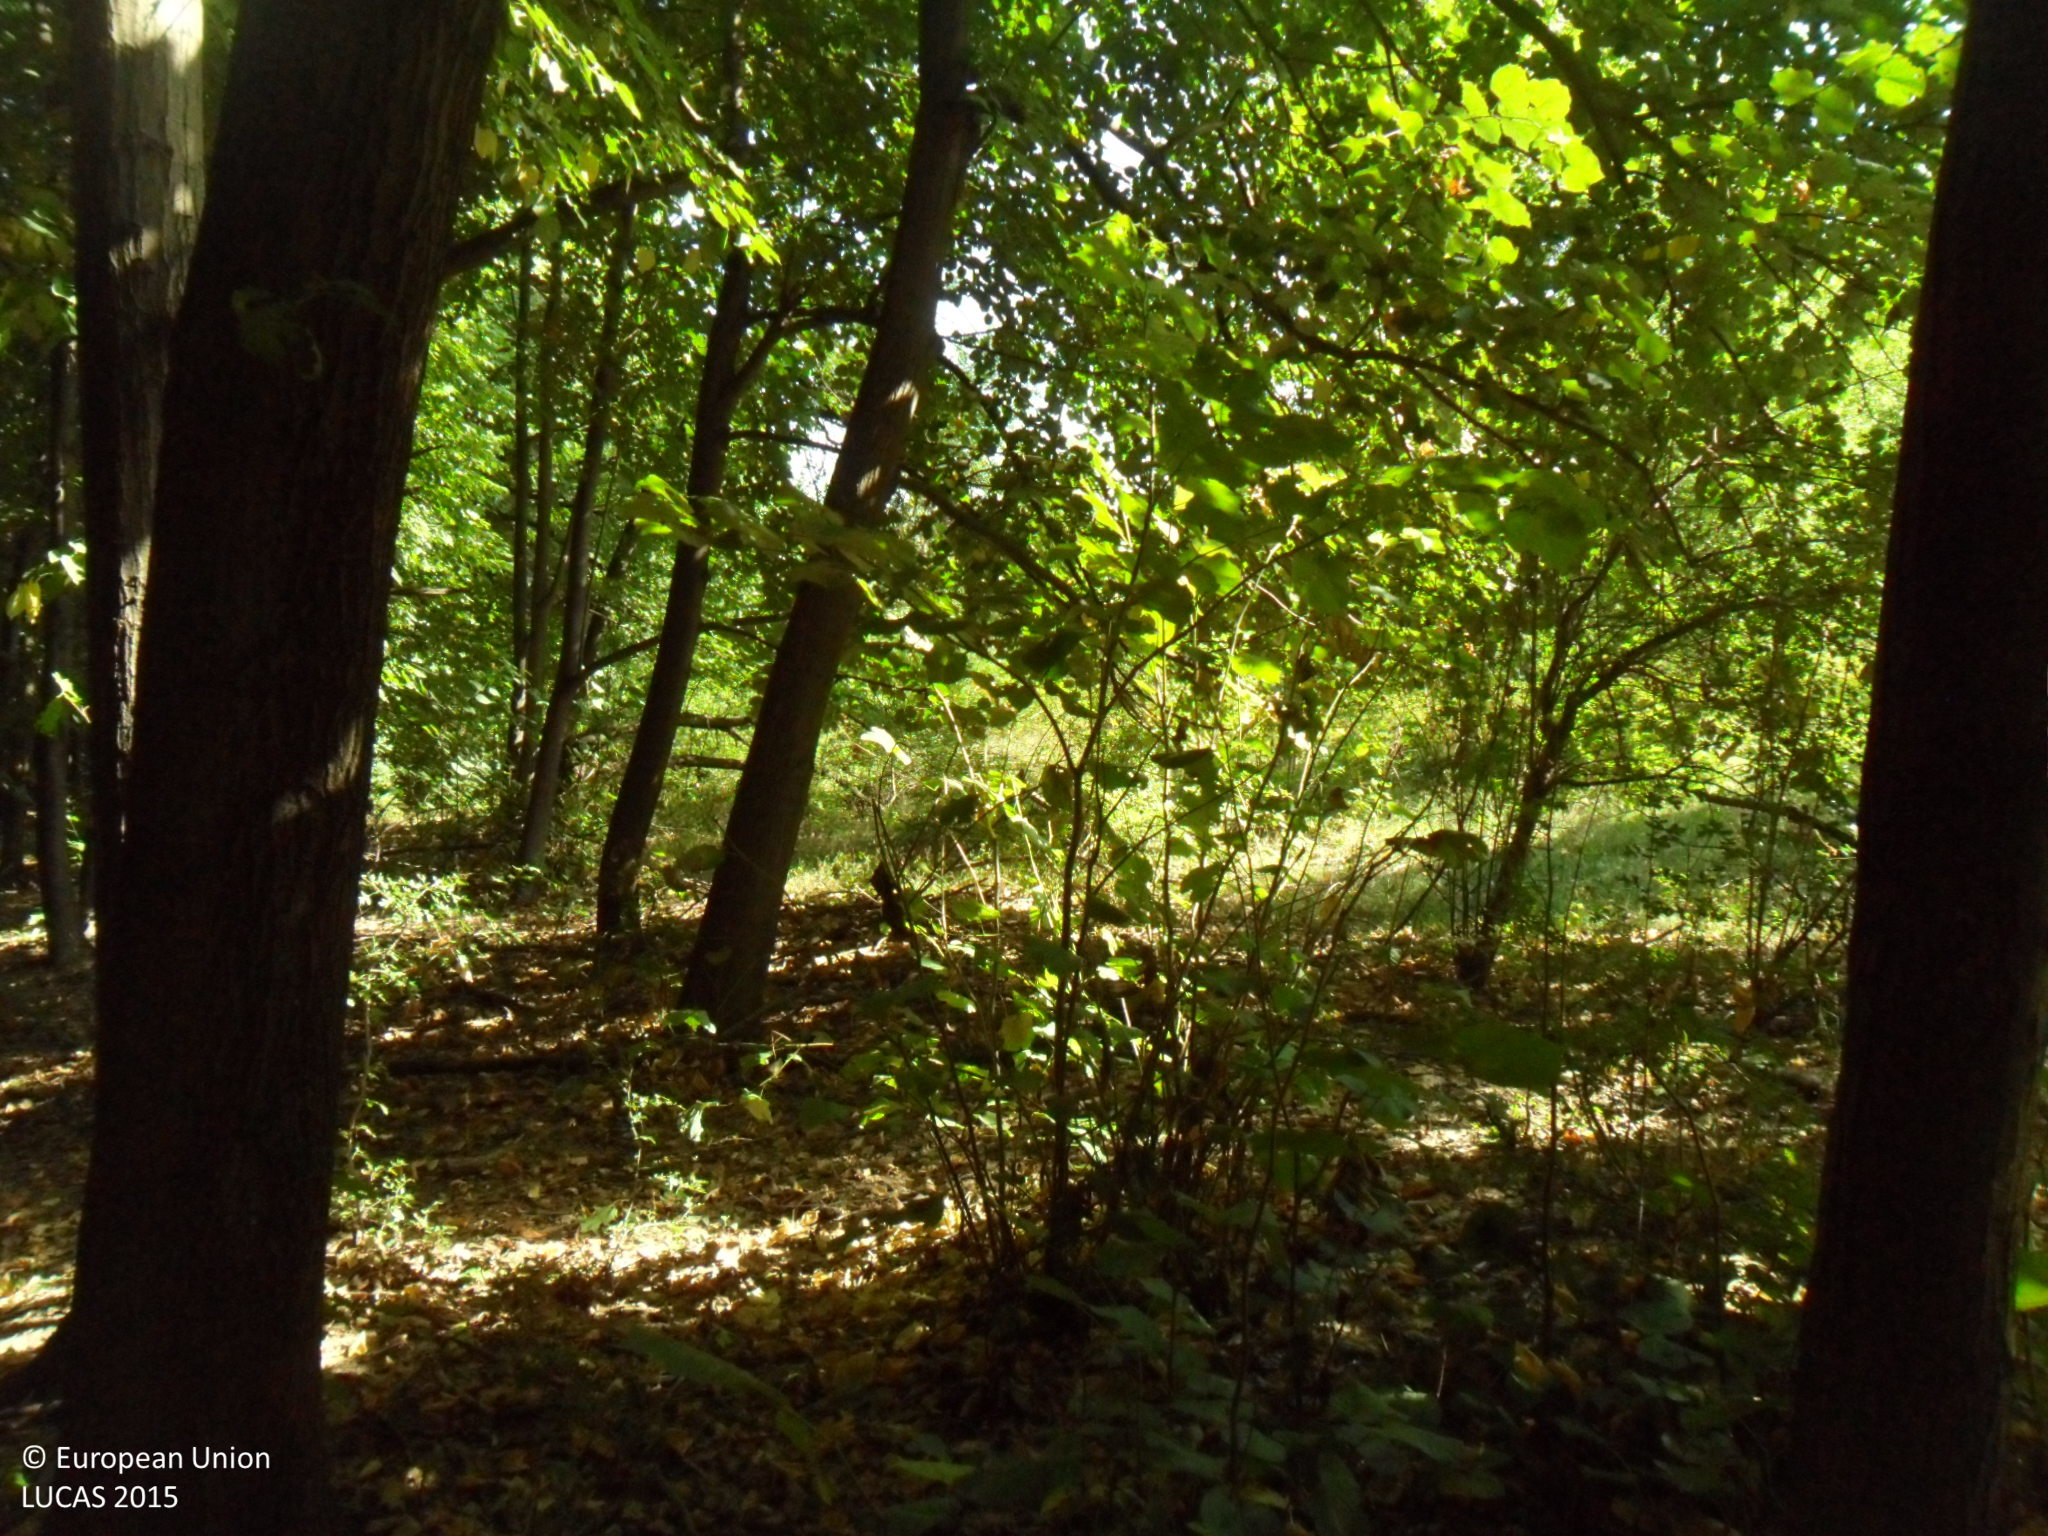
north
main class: Woodland
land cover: Broadleaved woodland
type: beech forest
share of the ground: > 75 %
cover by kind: broadleaved forest trees 95 %, unconsolidated bare surface 5 %
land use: Forestry
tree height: > 5 m
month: September
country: BG
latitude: 43.9117
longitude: 26.4328
